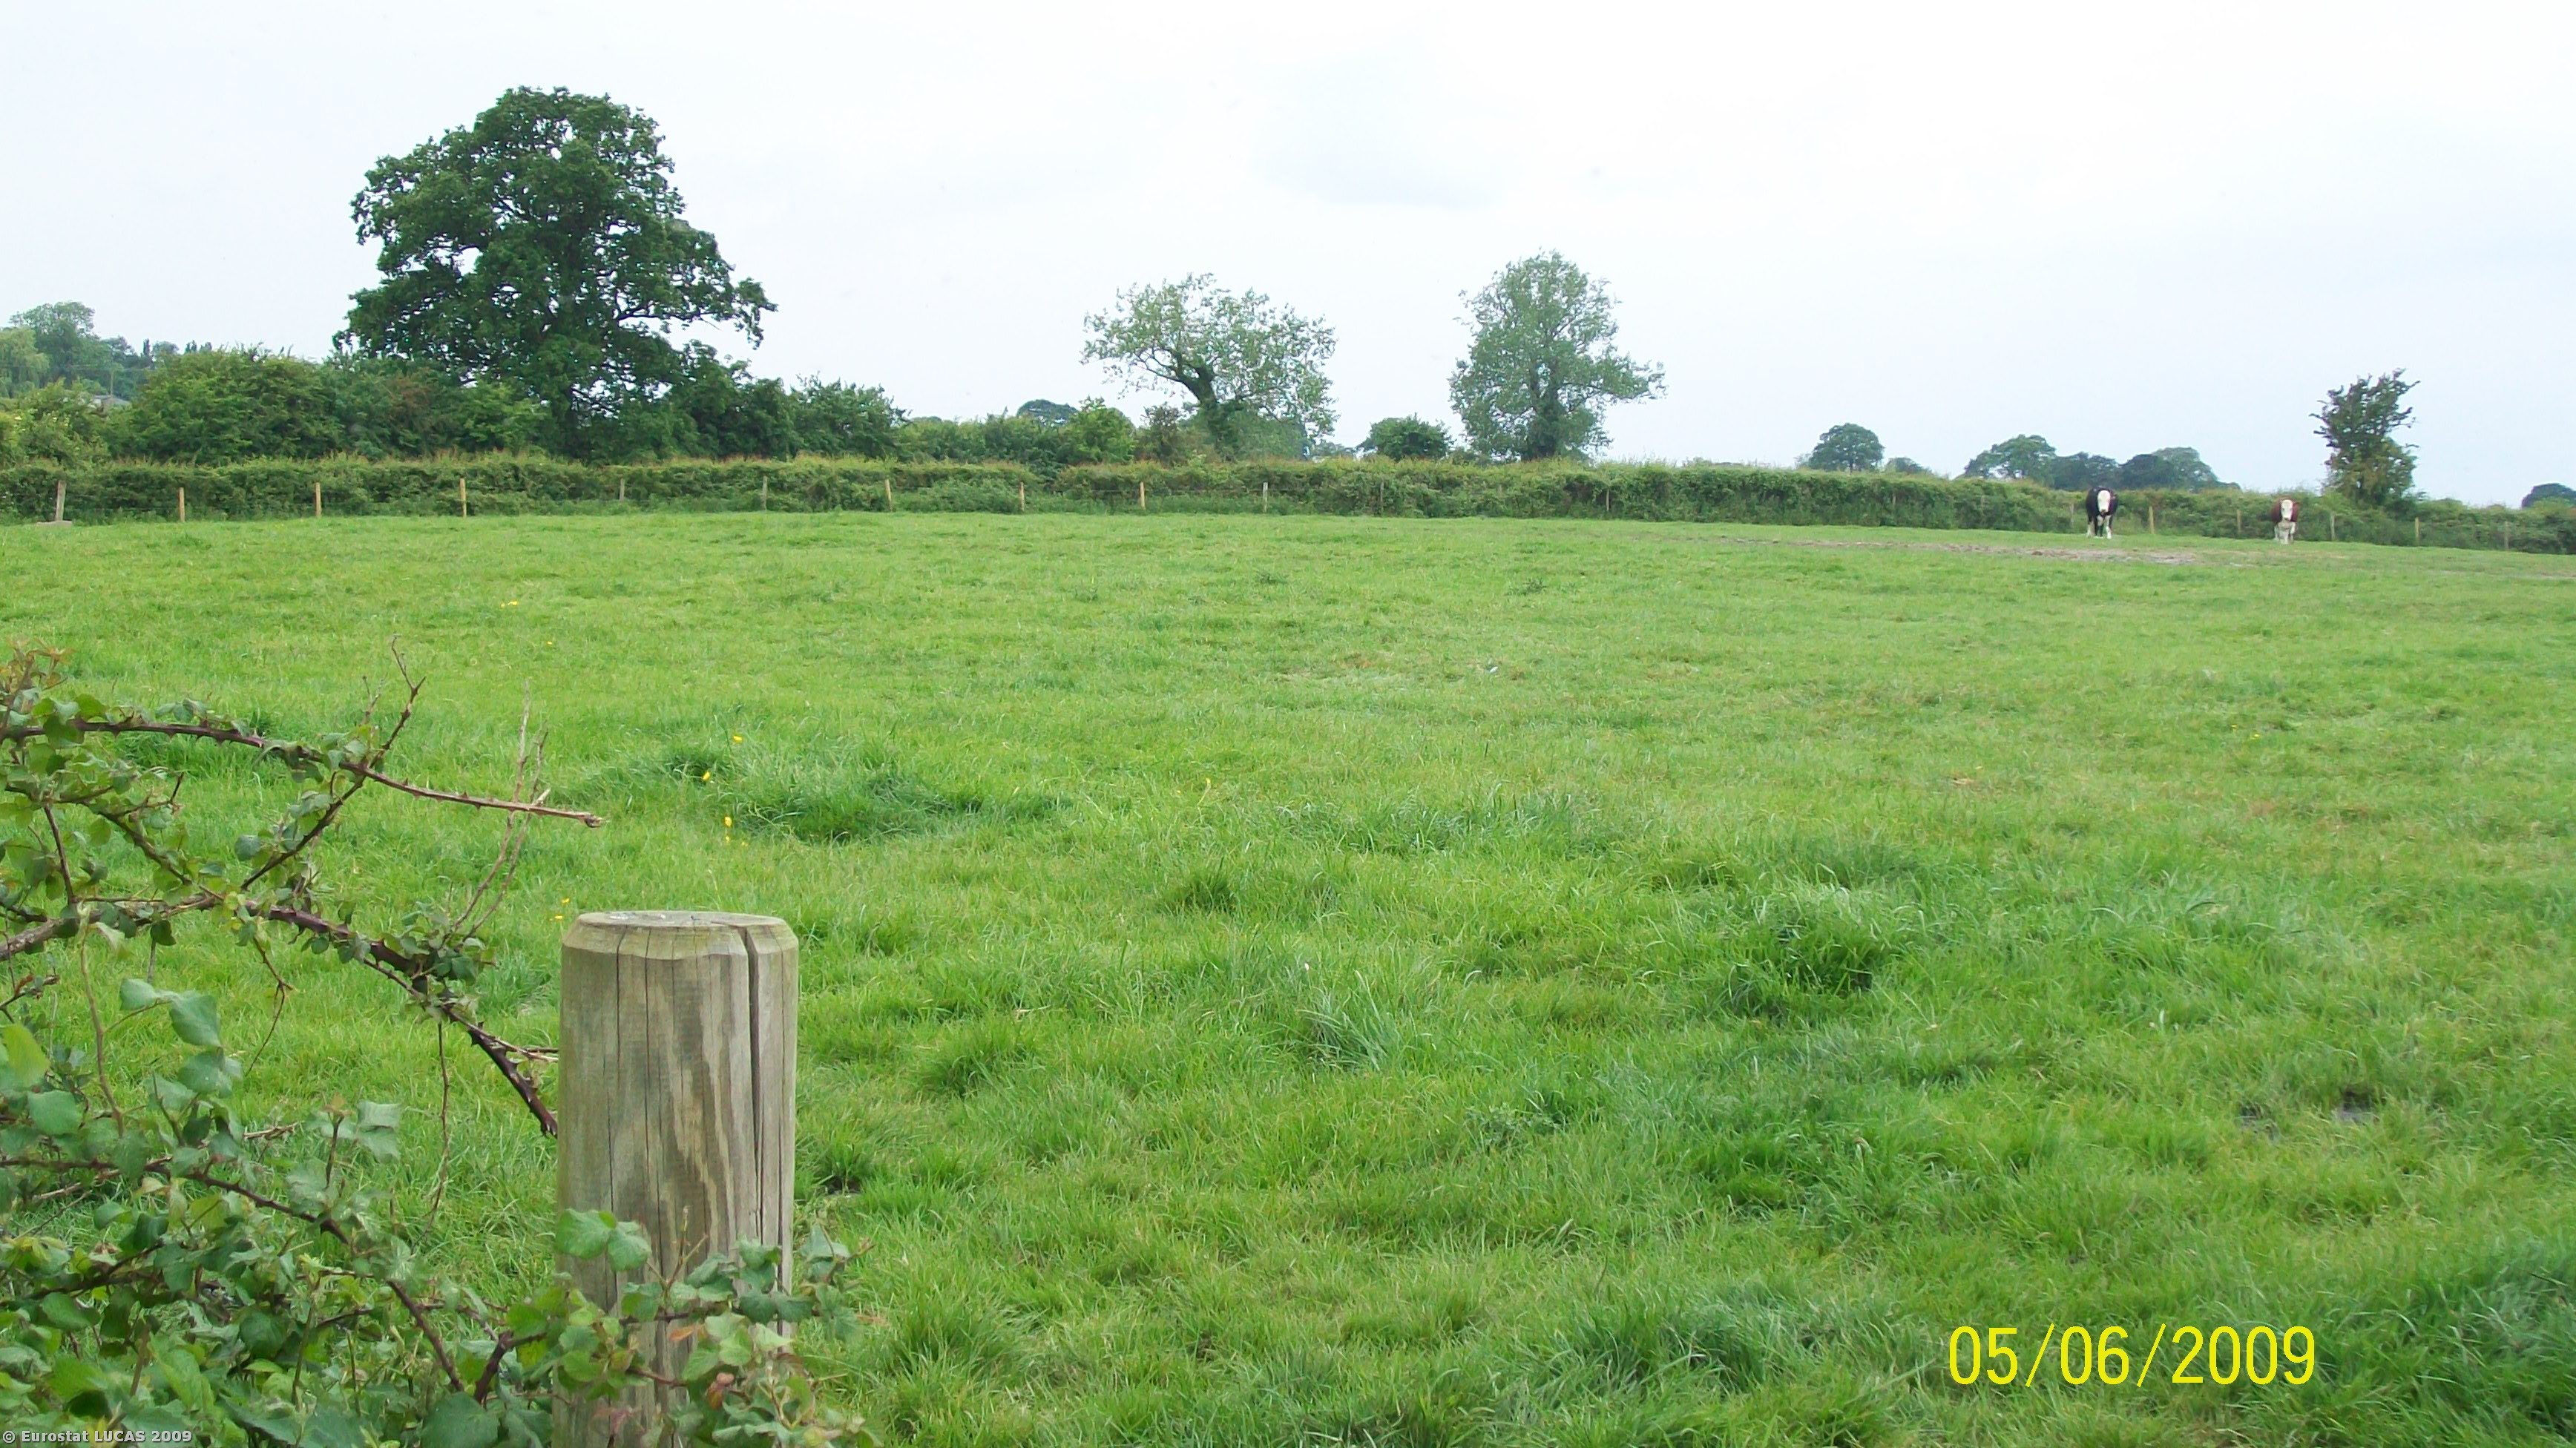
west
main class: Grassland
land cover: Grassland without tree/shrub cover
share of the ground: > 75 %
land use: Agriculture (excluding fallow land and kitchen gardens)
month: June
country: GB
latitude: 53.1596
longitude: -2.7679
